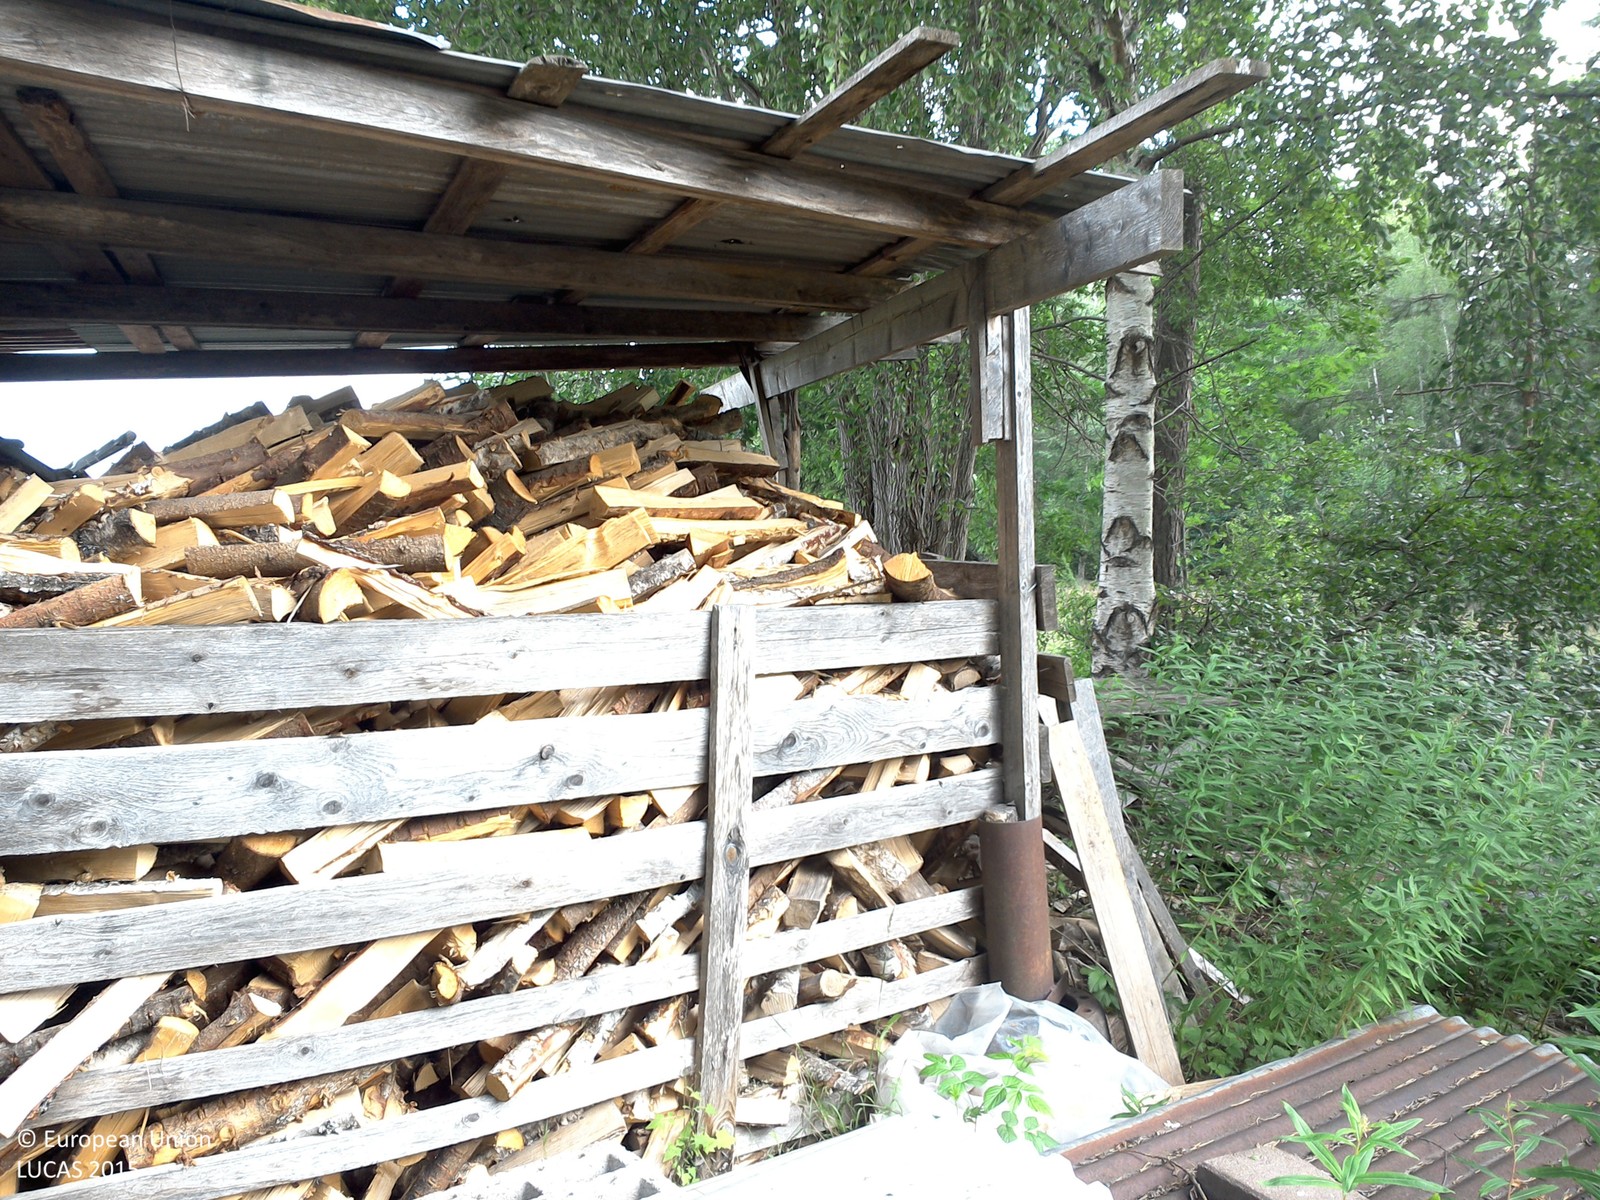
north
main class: Grassland
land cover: Spontaneously vegetated surfaces
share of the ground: > 75 %
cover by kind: herbaceous plants 50 %, unconsolidated bare surface 50 %
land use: Residential
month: July
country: SE
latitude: 58.0176
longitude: 15.0224
